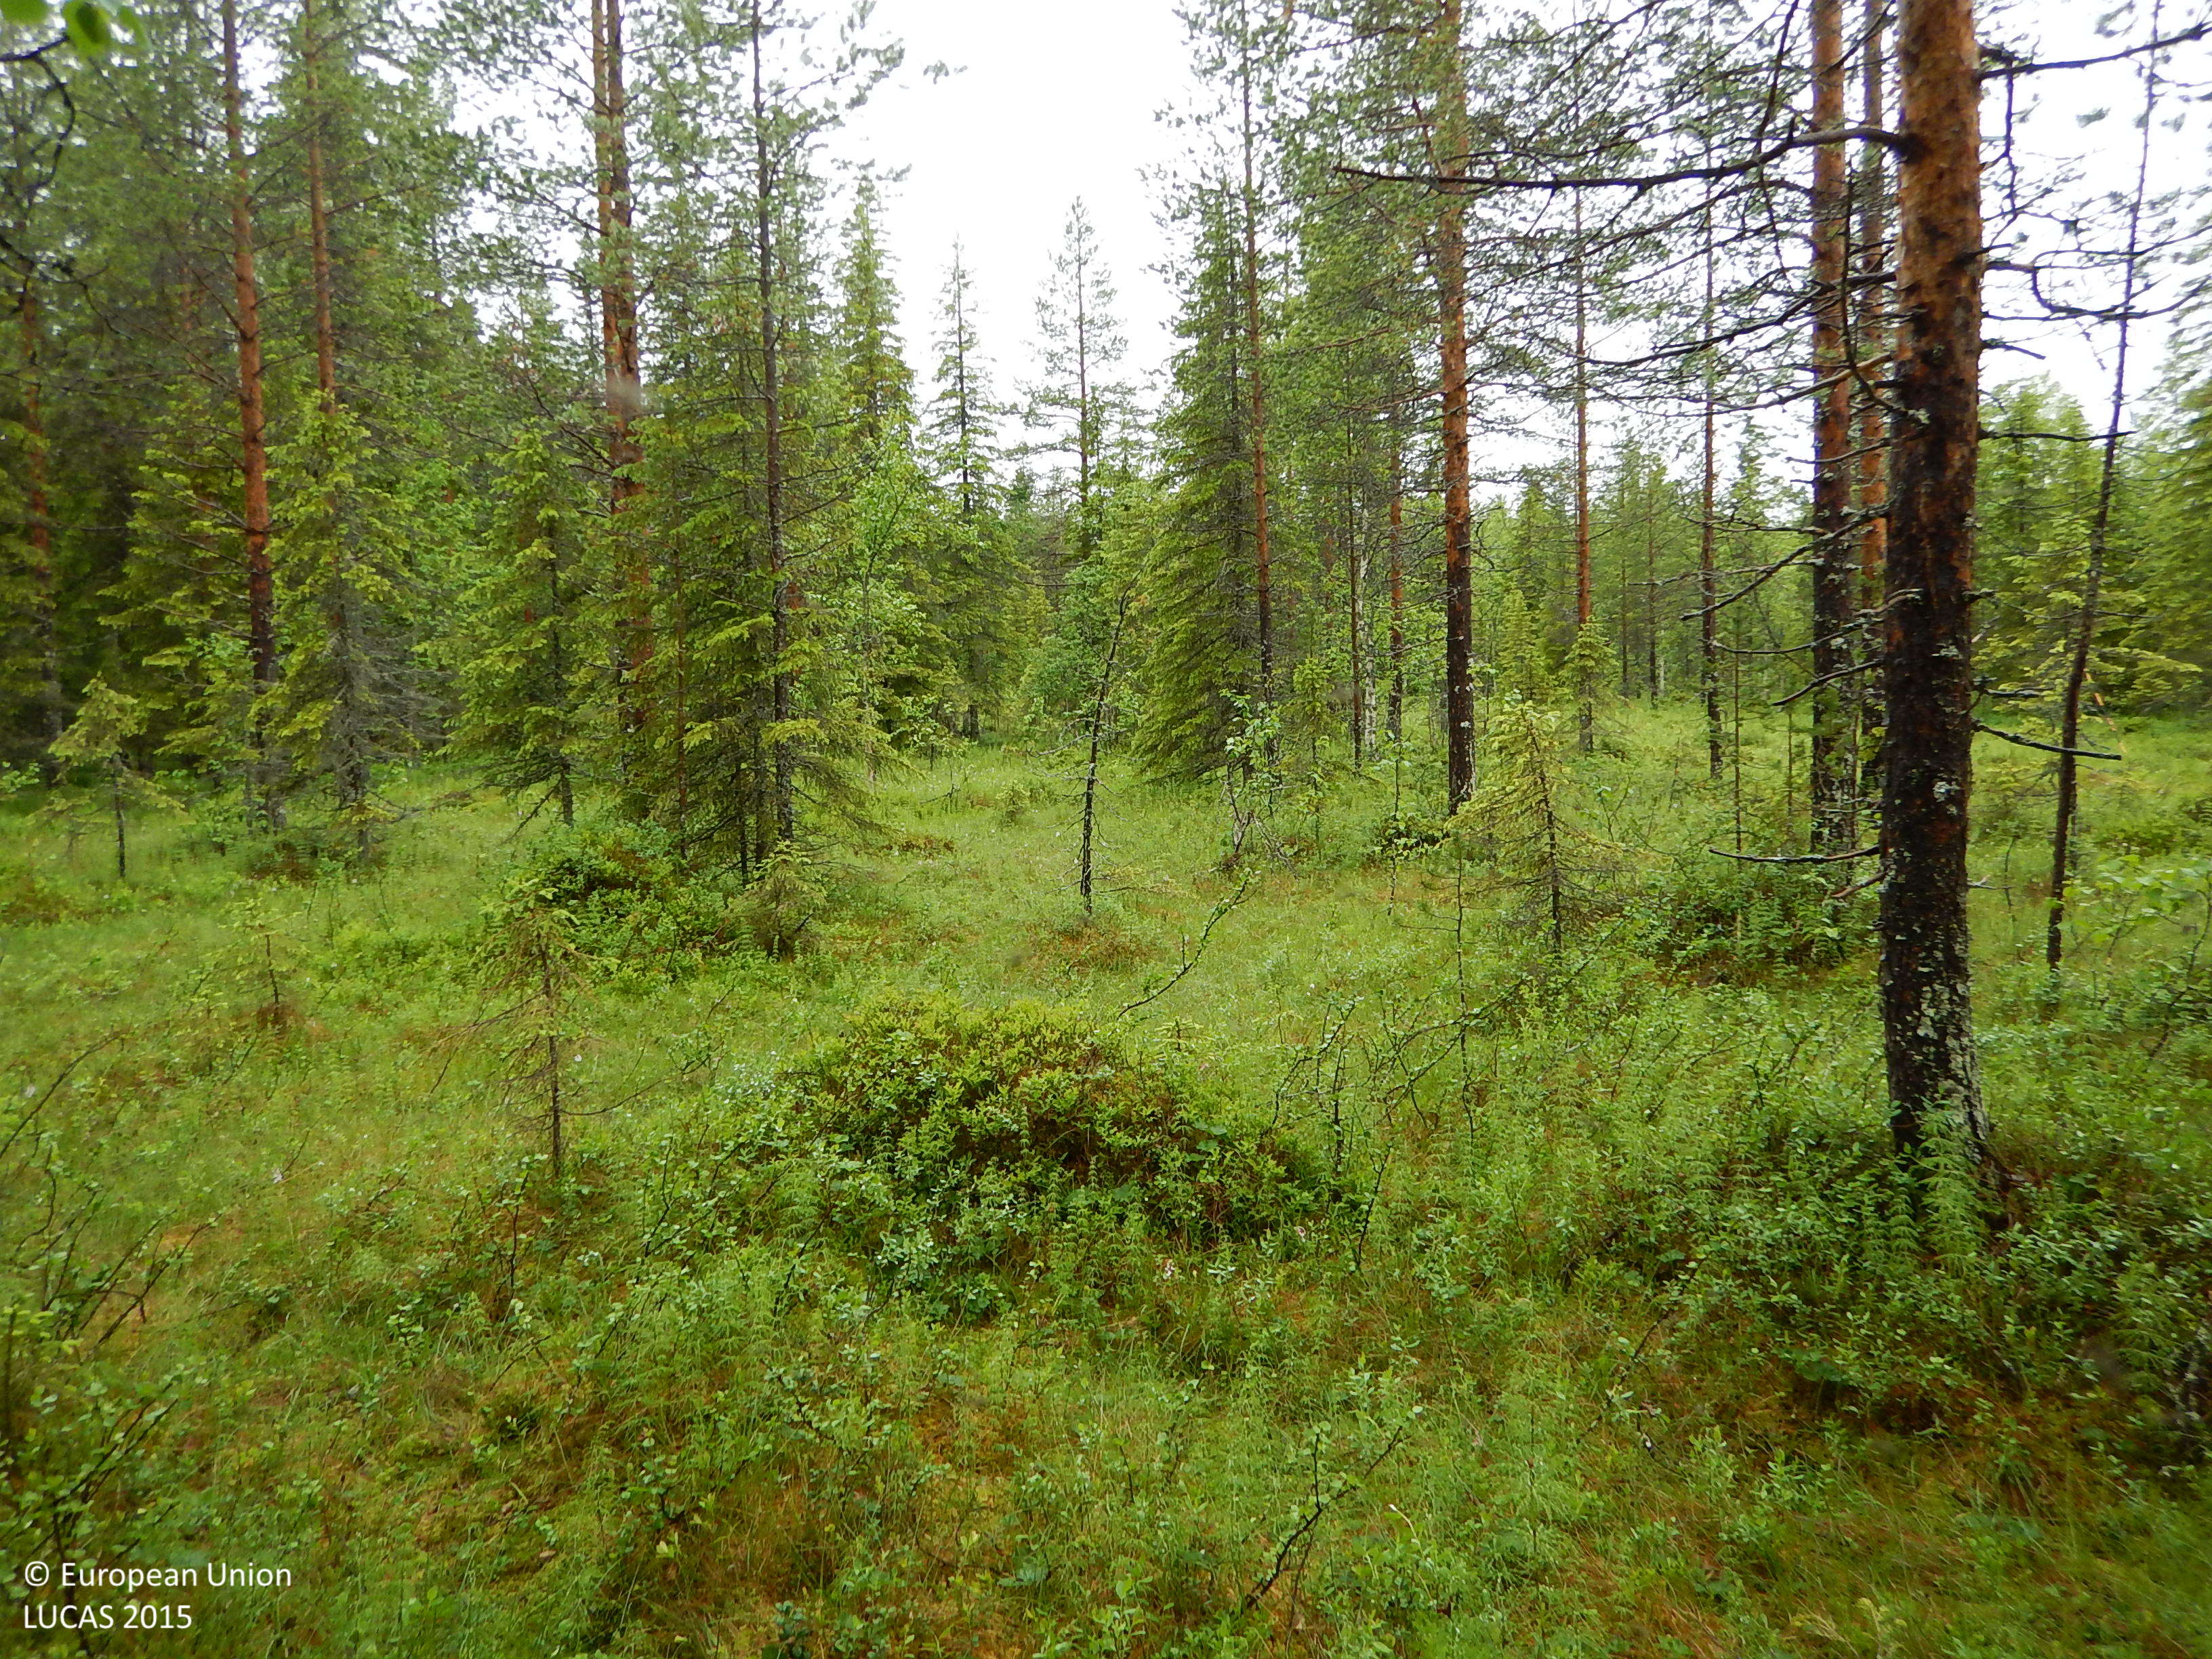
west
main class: Woodland
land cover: Other mixed woodland
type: boreal forest
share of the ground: 50 - 75 %
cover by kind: coniferous forest trees 40 %, herbaceous plants 20 %, lichens and mosses 20 %, broadleaved forest trees 15 %, shrubs 5 %
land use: Forestry
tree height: > 5 m
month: September
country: SE
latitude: 65.0953
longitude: 18.8816
